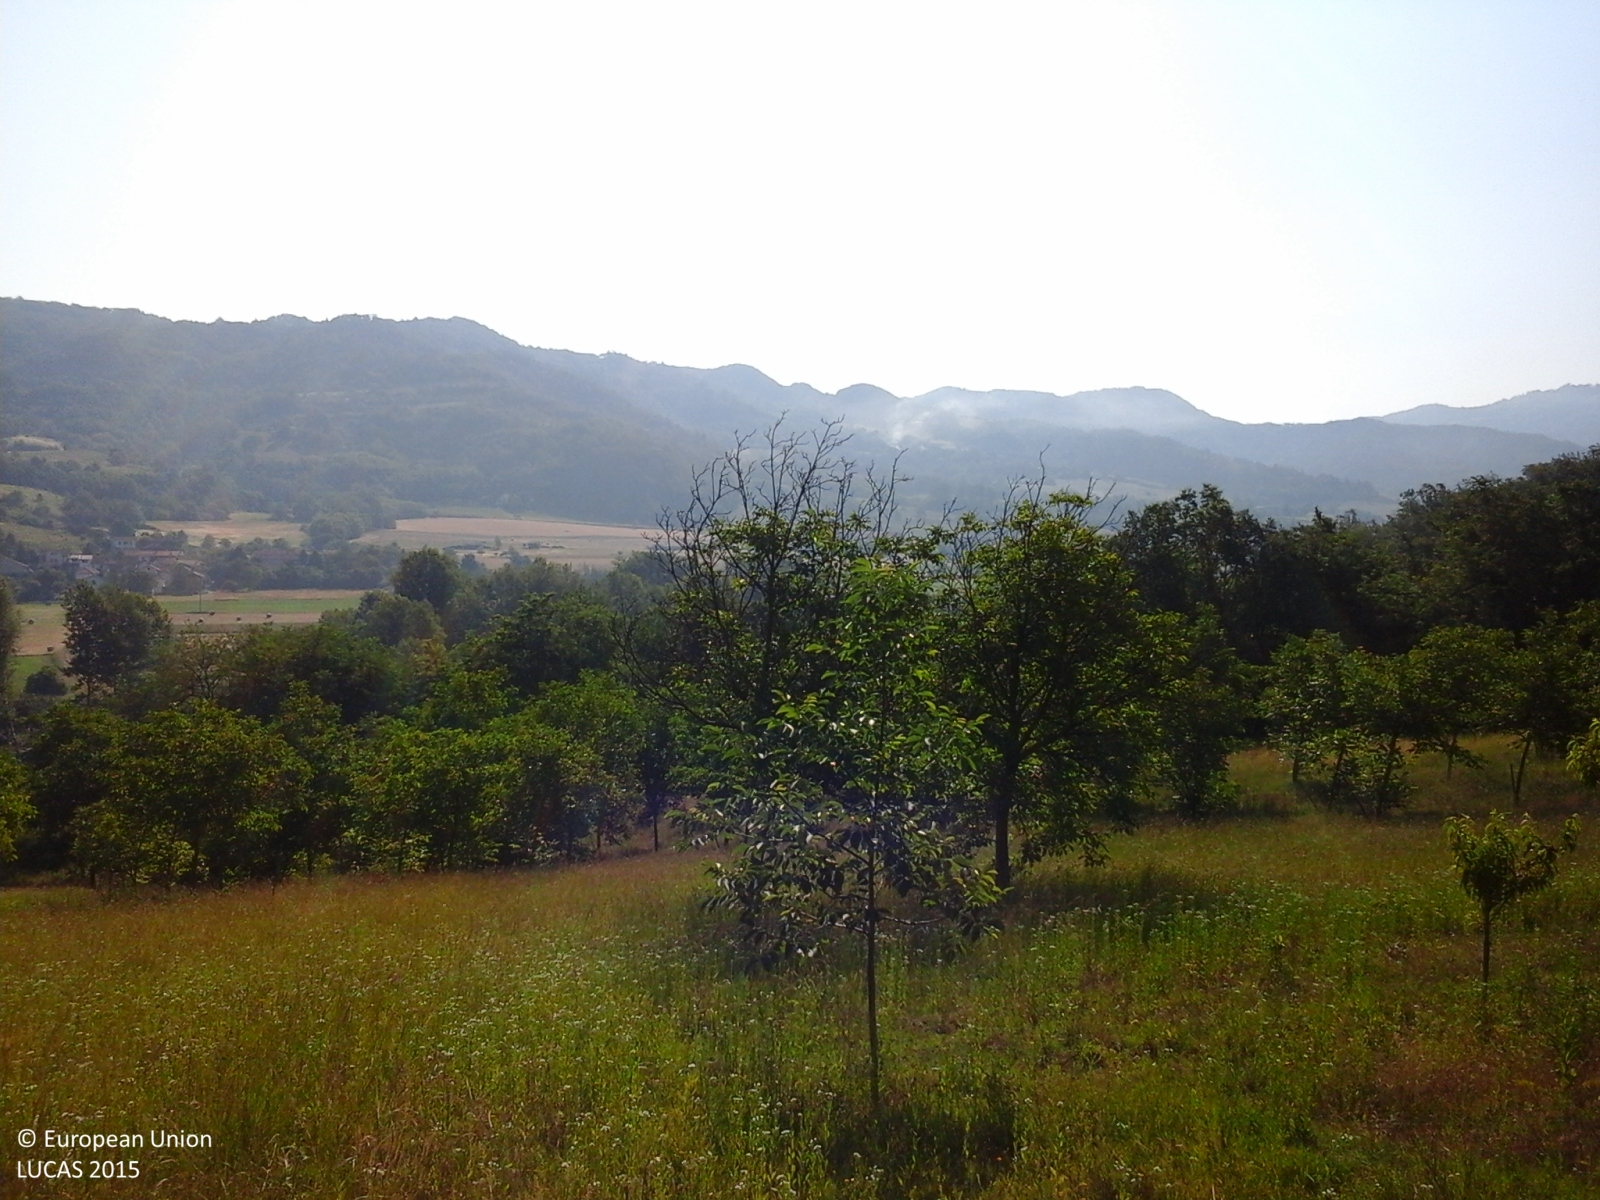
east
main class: Grassland
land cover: Grassland with sparse tree/shrub cover
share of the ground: > 75 %
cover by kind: herbaceous plants 90 %, broadleaved forest trees 5 %, shrubs 5 %
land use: Agriculture (excluding fallow land and kitchen gardens)
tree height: < 5 m
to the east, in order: Grassland with sparse tree/shrub cover; Nuts trees; Tracks; Artificial constructions in urban areas; Broadleaved woodland; Inland fresh running water
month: June
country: IT
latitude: 44.6088
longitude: 8.4031
